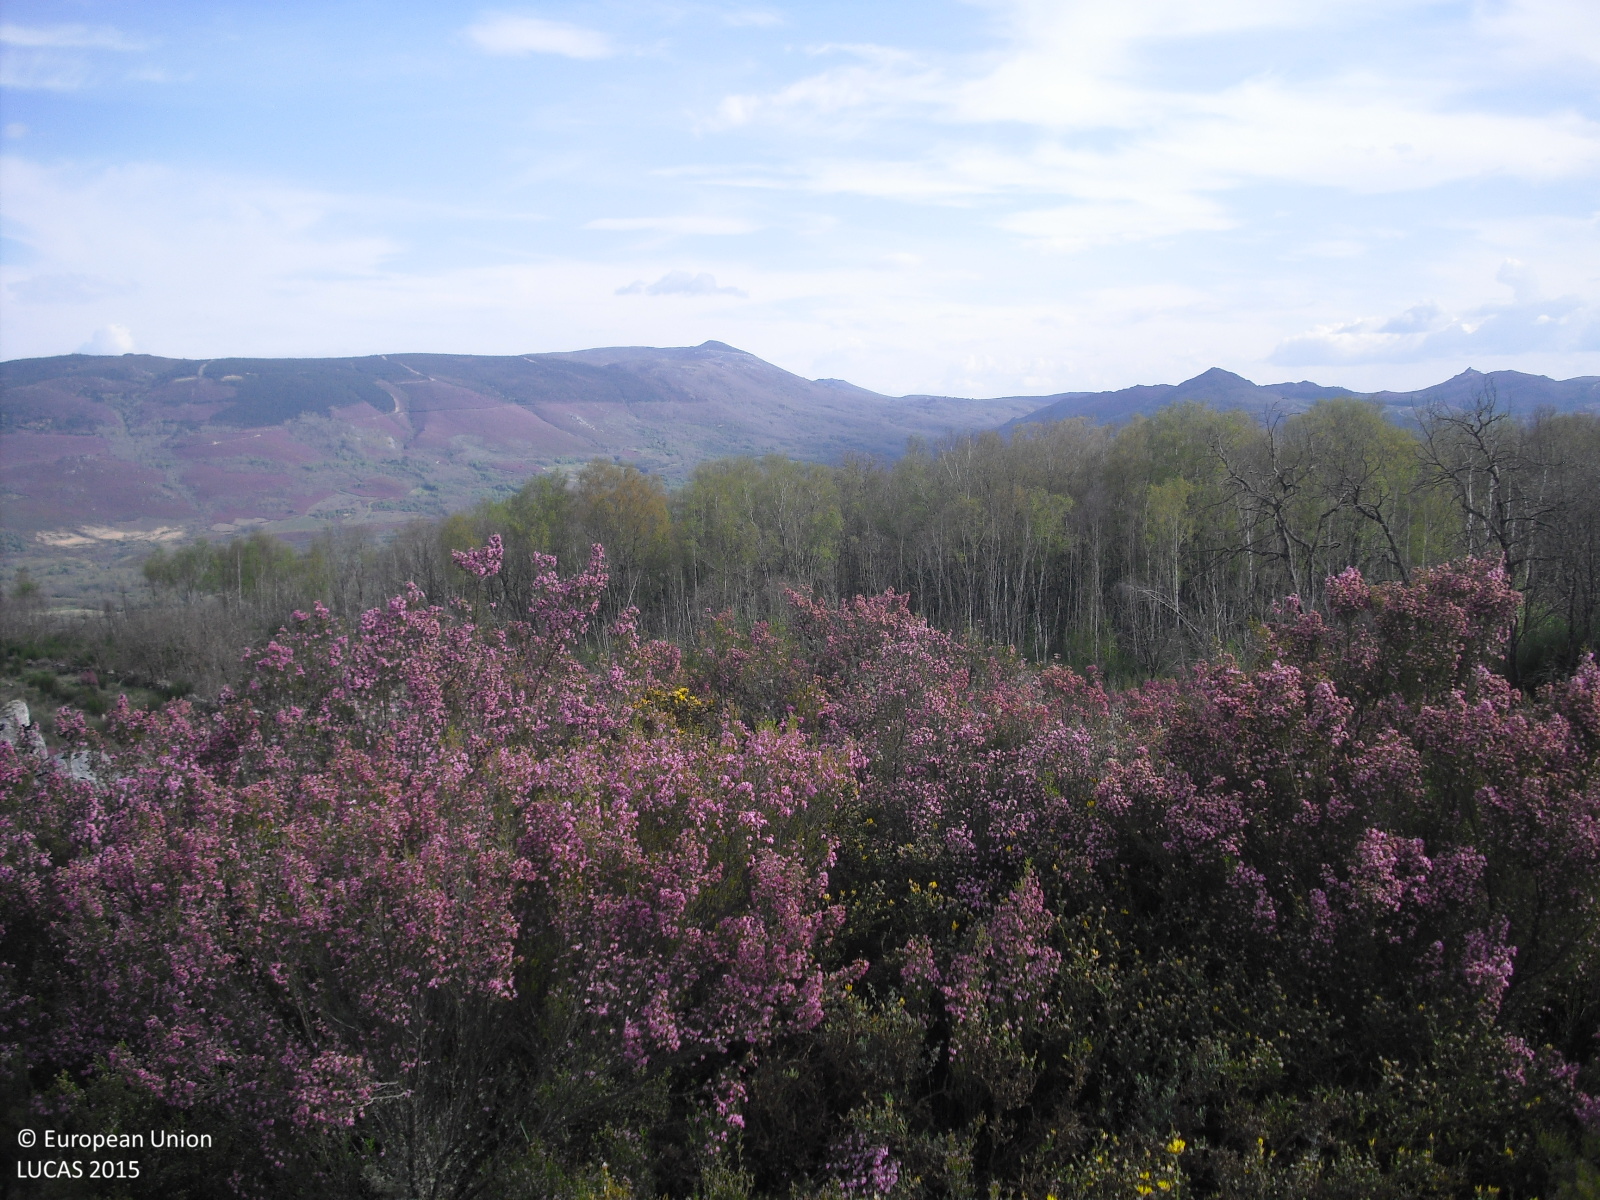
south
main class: Woodland
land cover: Pine dominated coniferous woodland
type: exotic forest
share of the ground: 10 - 25 %
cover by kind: shrubs 70 %, coniferous forest trees 15 %, consolidated bare surface 15 %
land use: Forestry
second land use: Other primary production
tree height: < 5 m
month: April
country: ES
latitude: 41.9580
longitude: -7.7435
